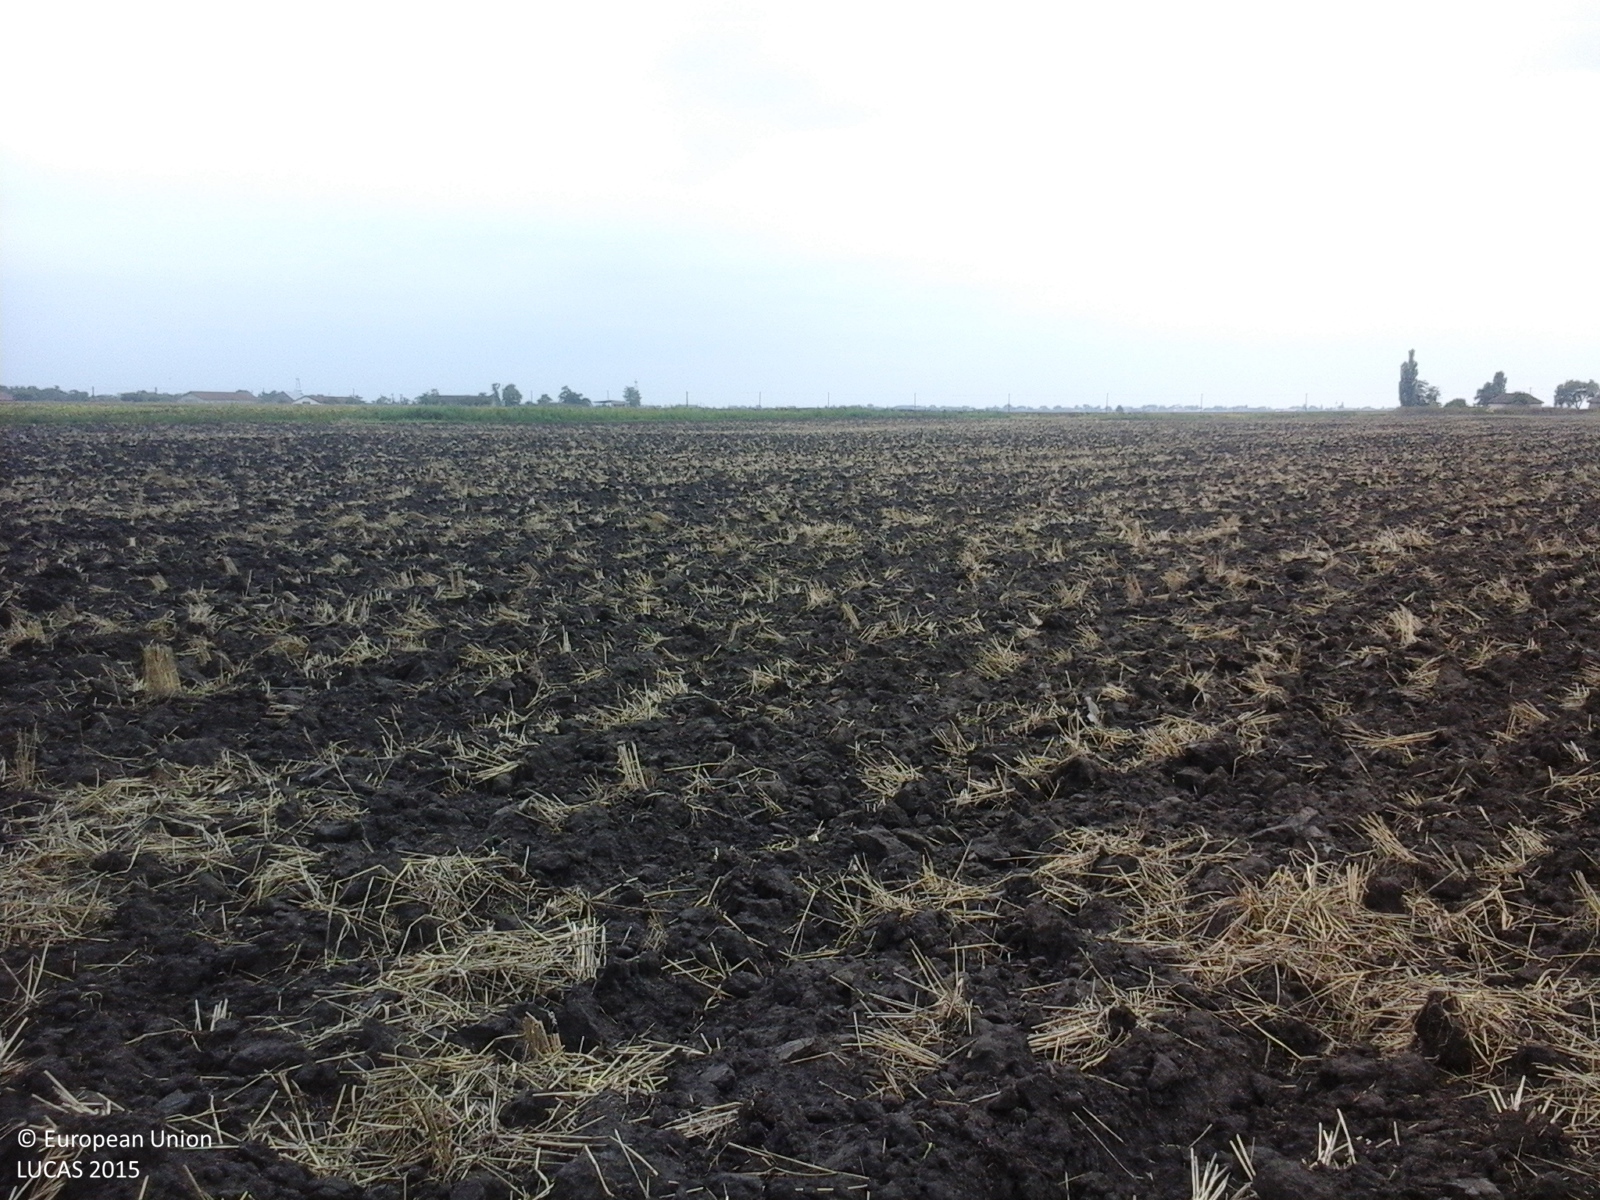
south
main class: Cropland
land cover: Common wheat
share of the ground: < 10 %
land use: Agriculture (excluding fallow land and kitchen gardens)
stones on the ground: < 10 %
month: August
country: RO
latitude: 46.1520
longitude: 20.3951
